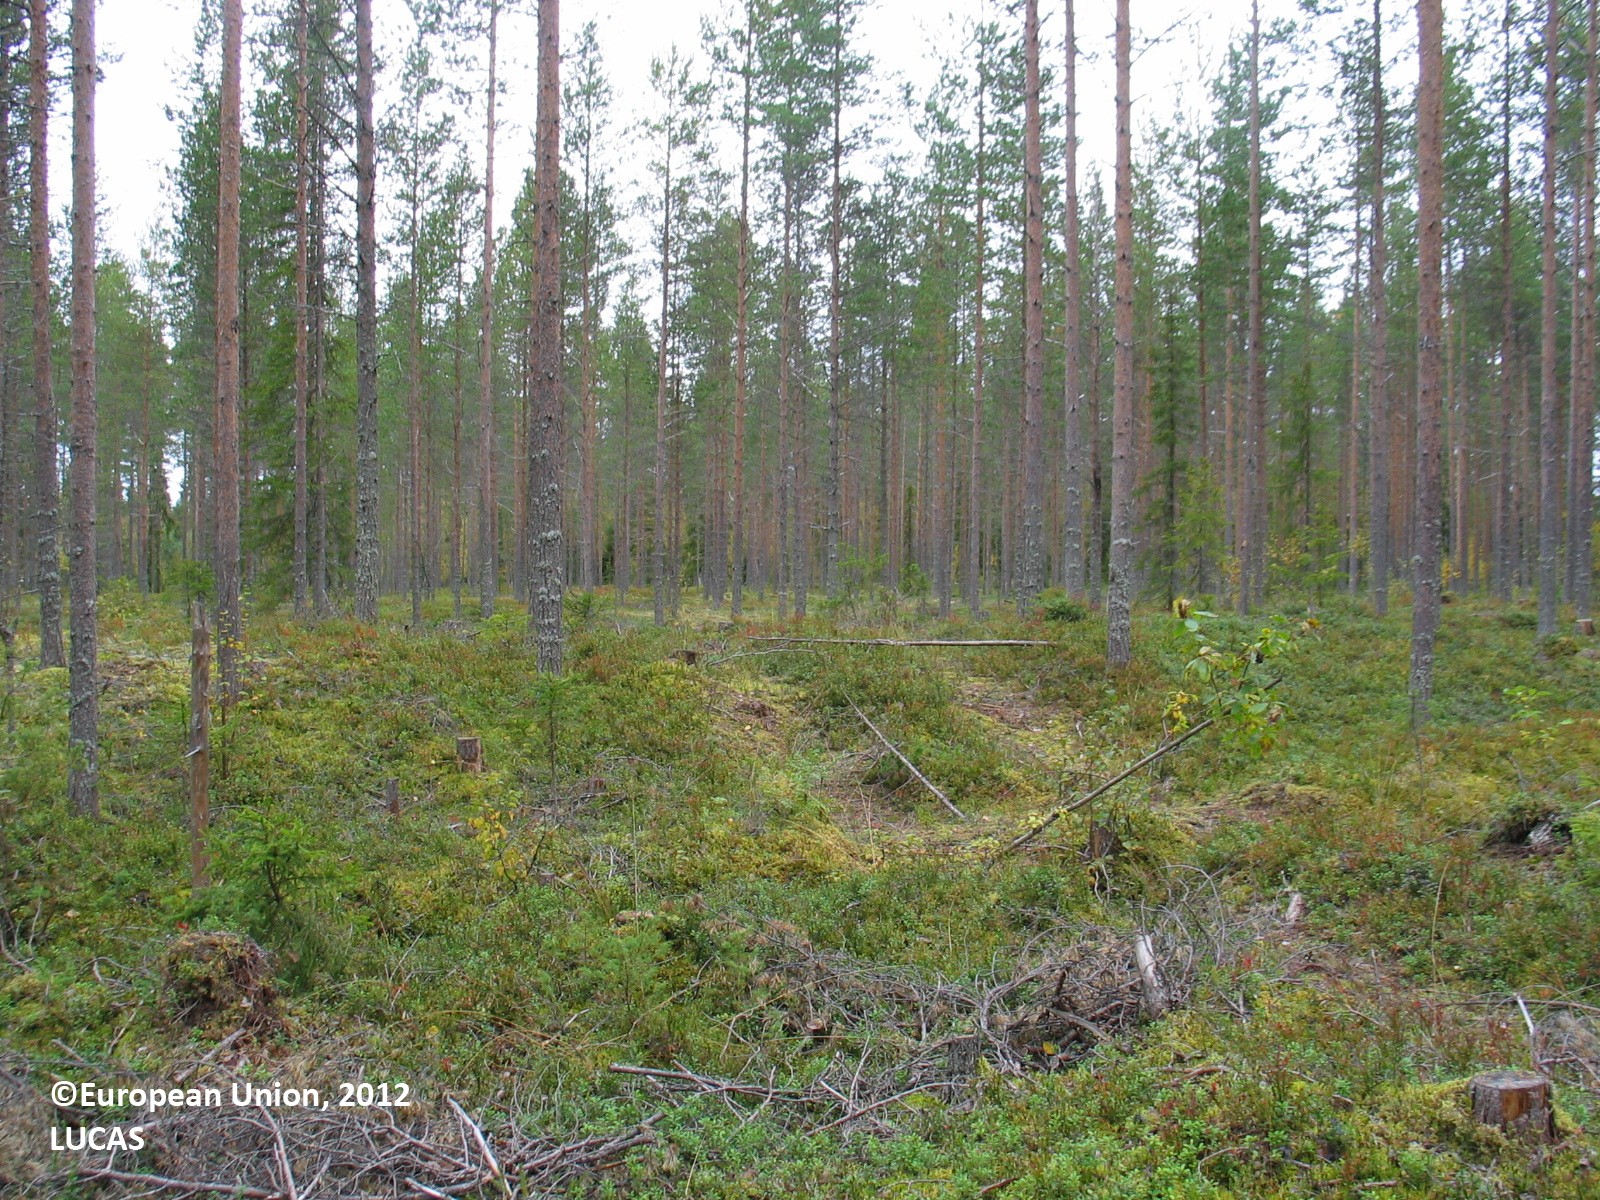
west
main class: Woodland
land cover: Pine dominated coniferous woodland
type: boreal forest
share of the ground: 25 - 50 %
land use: Forestry
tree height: > 5 m
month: September
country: FI
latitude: 65.4701
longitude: 25.6008
